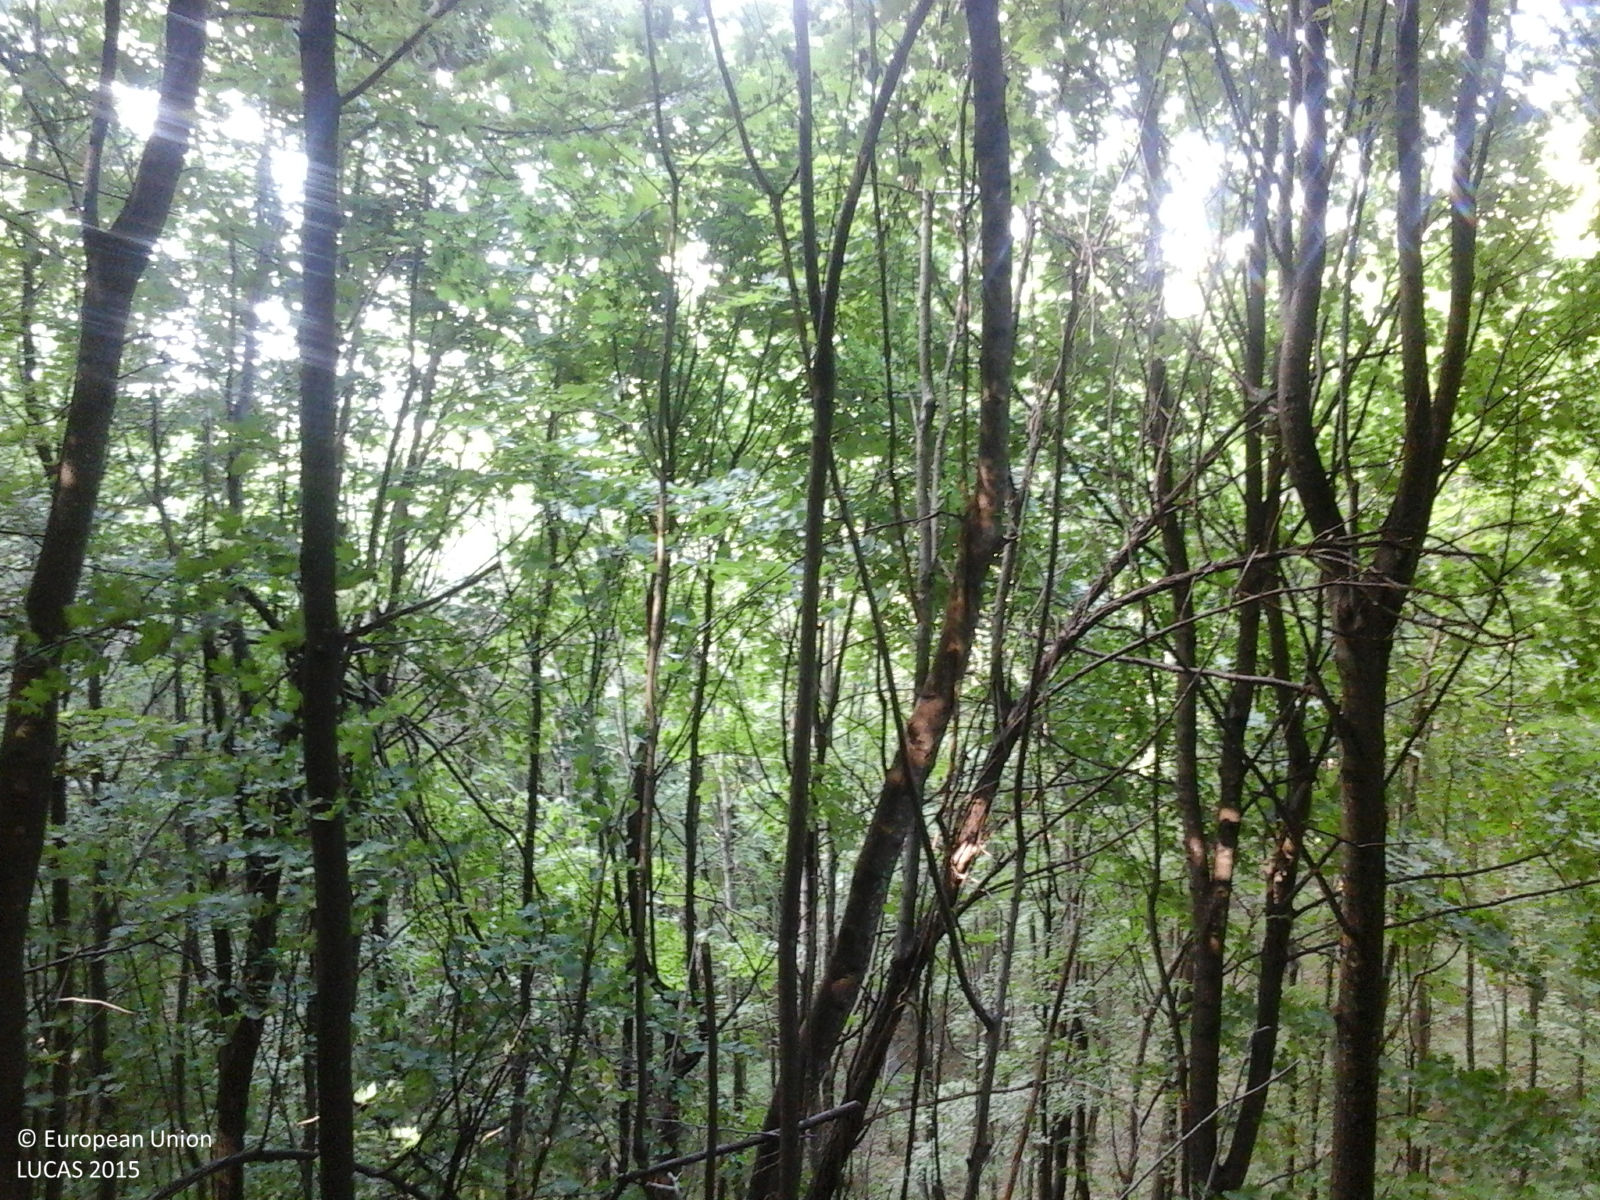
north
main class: Woodland
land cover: Broadleaved woodland
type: beech forest
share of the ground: > 75 %
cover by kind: broadleaved forest trees 100 %
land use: Forestry
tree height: > 5 m
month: June
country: RO
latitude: 46.7722
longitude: 27.2745
